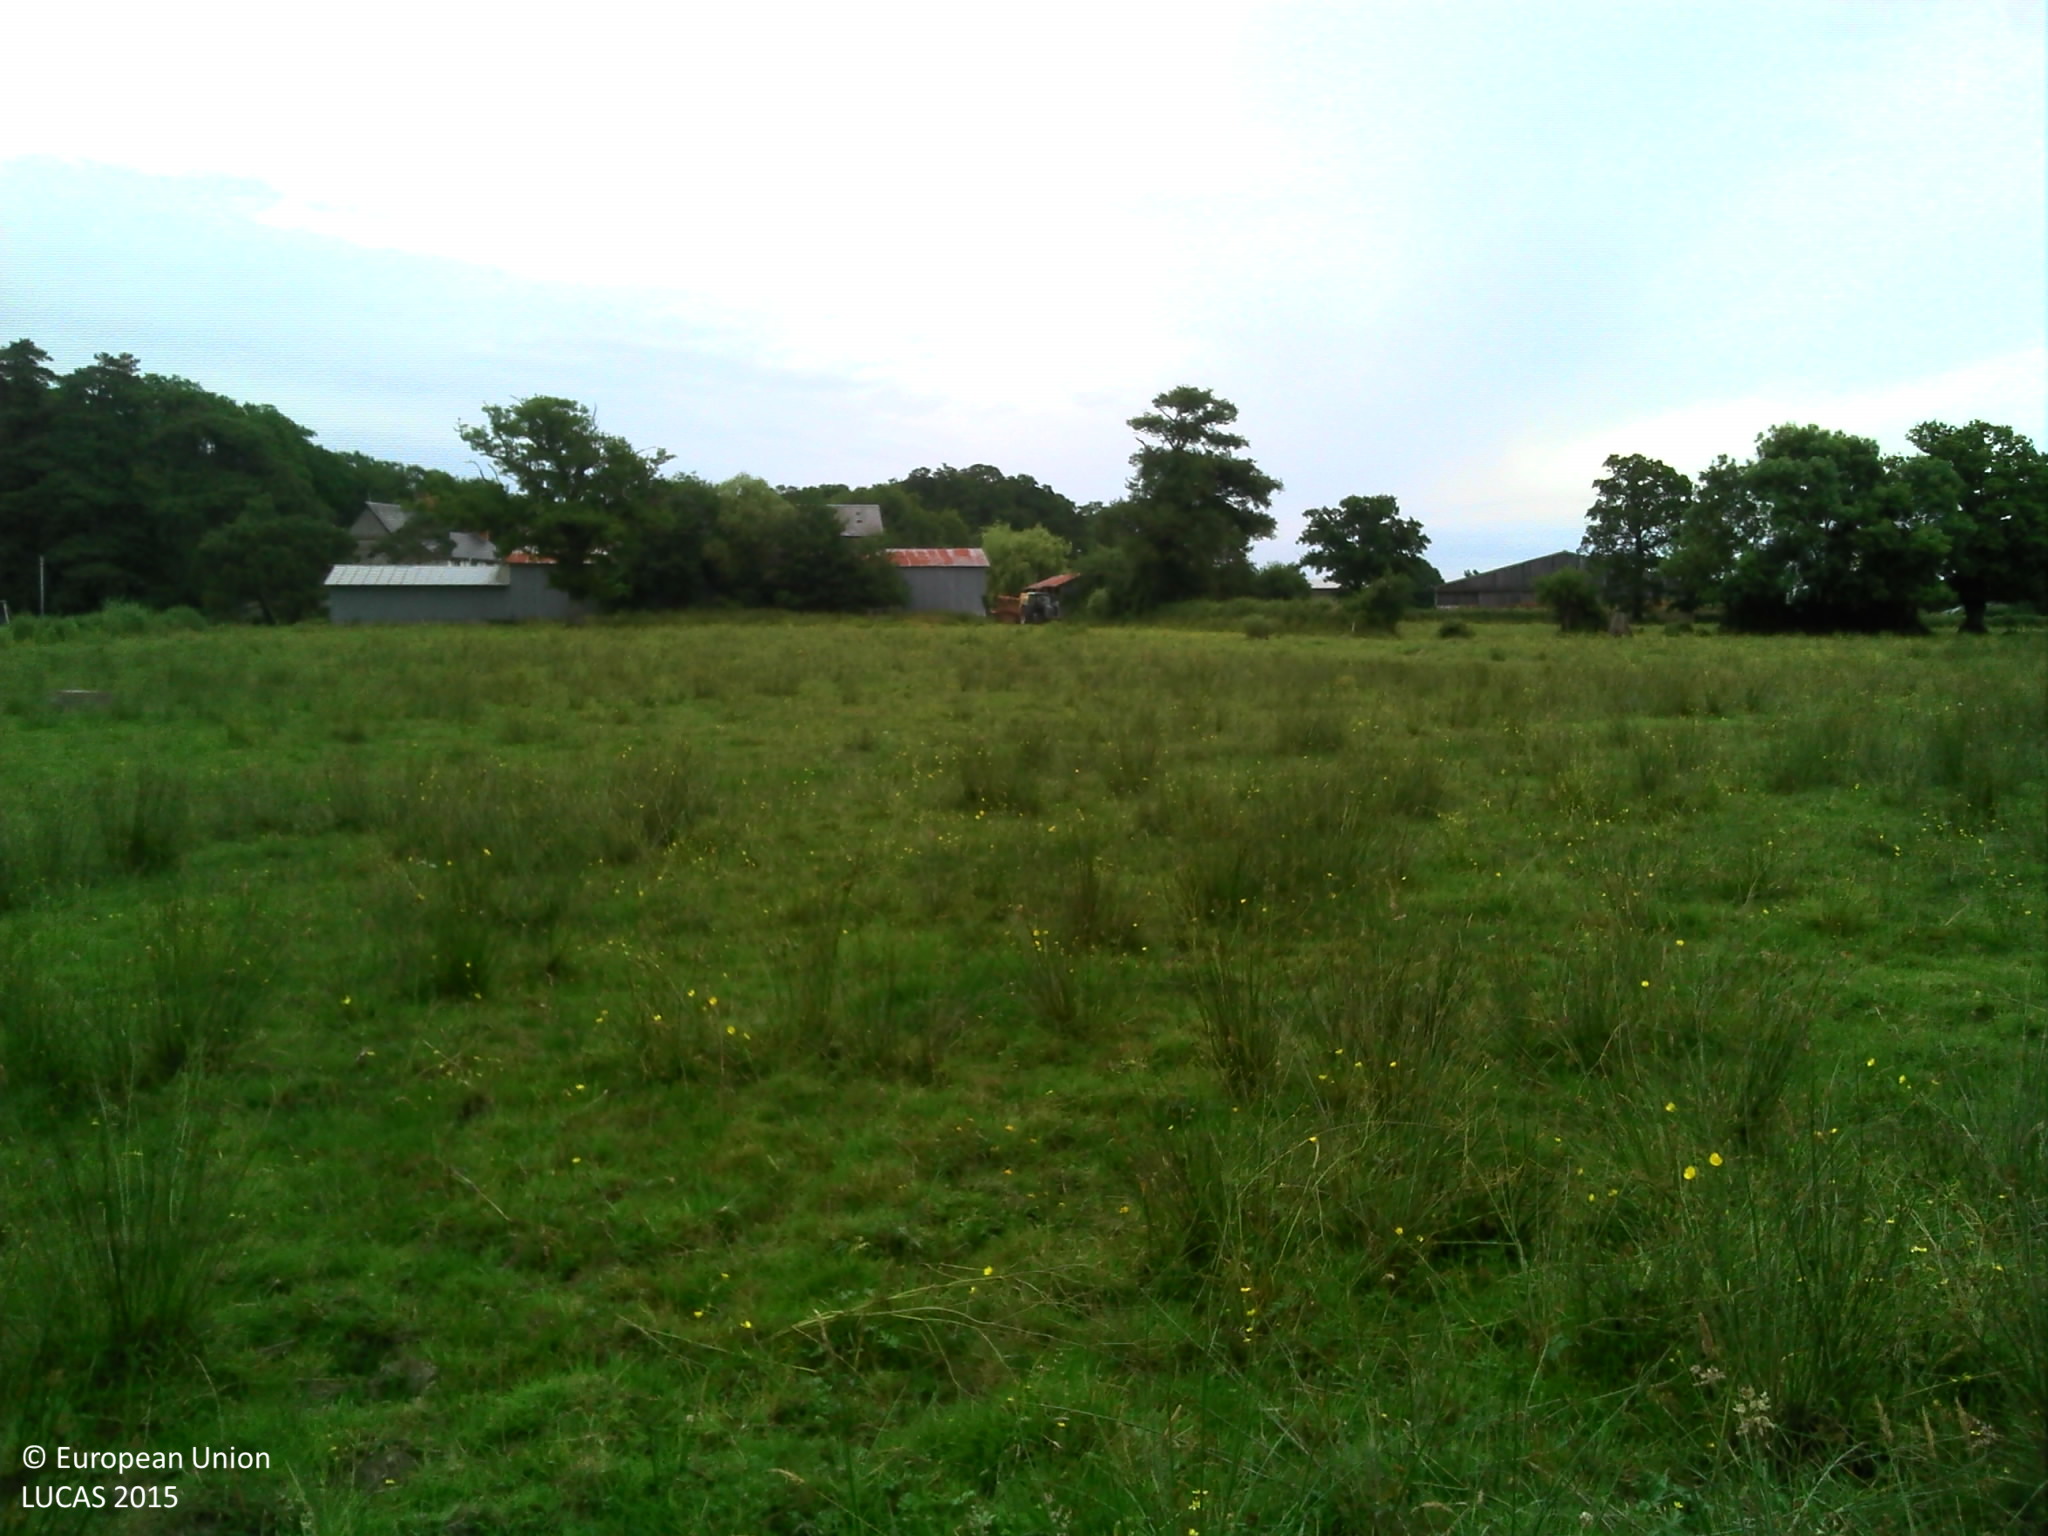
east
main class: Grassland
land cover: Grassland without tree/shrub cover
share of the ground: > 75 %
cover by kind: herbaceous plants 100 %
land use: Agriculture (excluding fallow land and kitchen gardens)
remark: Temporary flooded
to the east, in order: Grassland without tree/shrub cover; Ditches and canals; Artificial constructions in urban areas; Ditches and canals; Broadleaved woodland
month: June
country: FR
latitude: 46.8375
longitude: -1.6717
